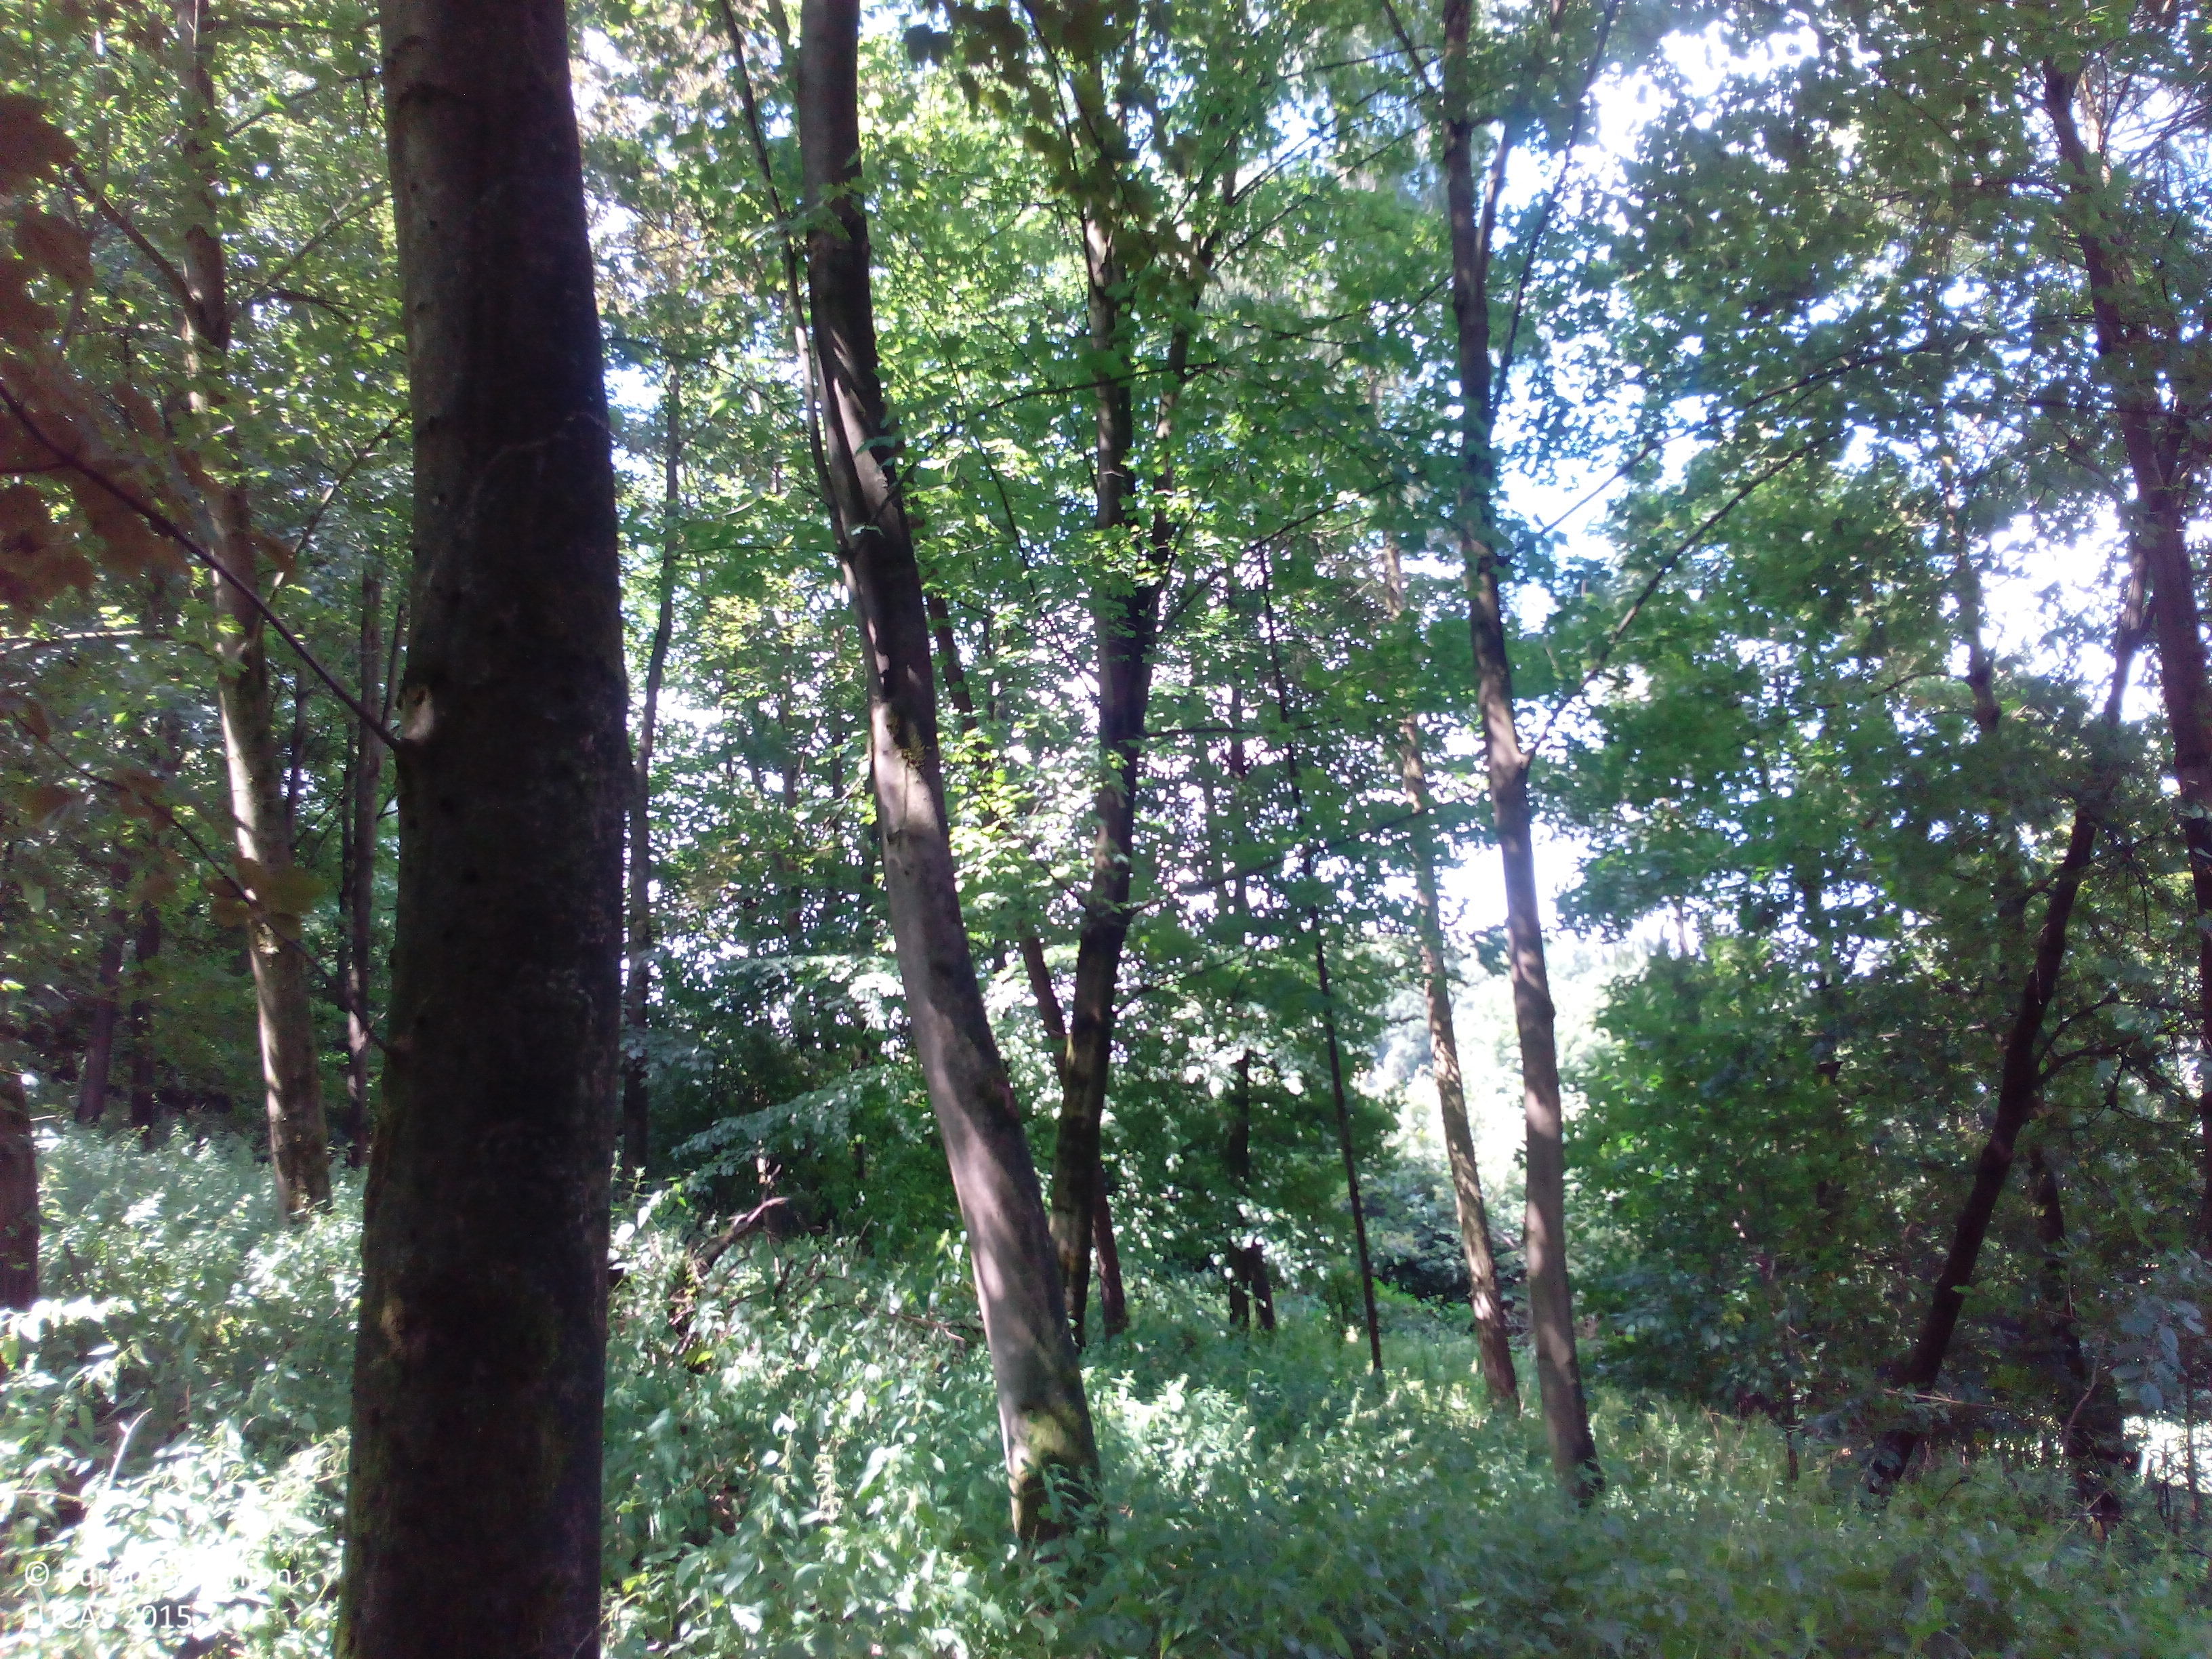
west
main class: Woodland
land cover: Broadleaved woodland
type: mesophytic deciduous forest
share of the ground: > 75 %
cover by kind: broadleaved forest trees 90 %, shrubs 5 %, herbaceous plants 5 %
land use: Forestry
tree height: > 5 m
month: July
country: DE
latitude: 52.2172
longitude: 8.0245
